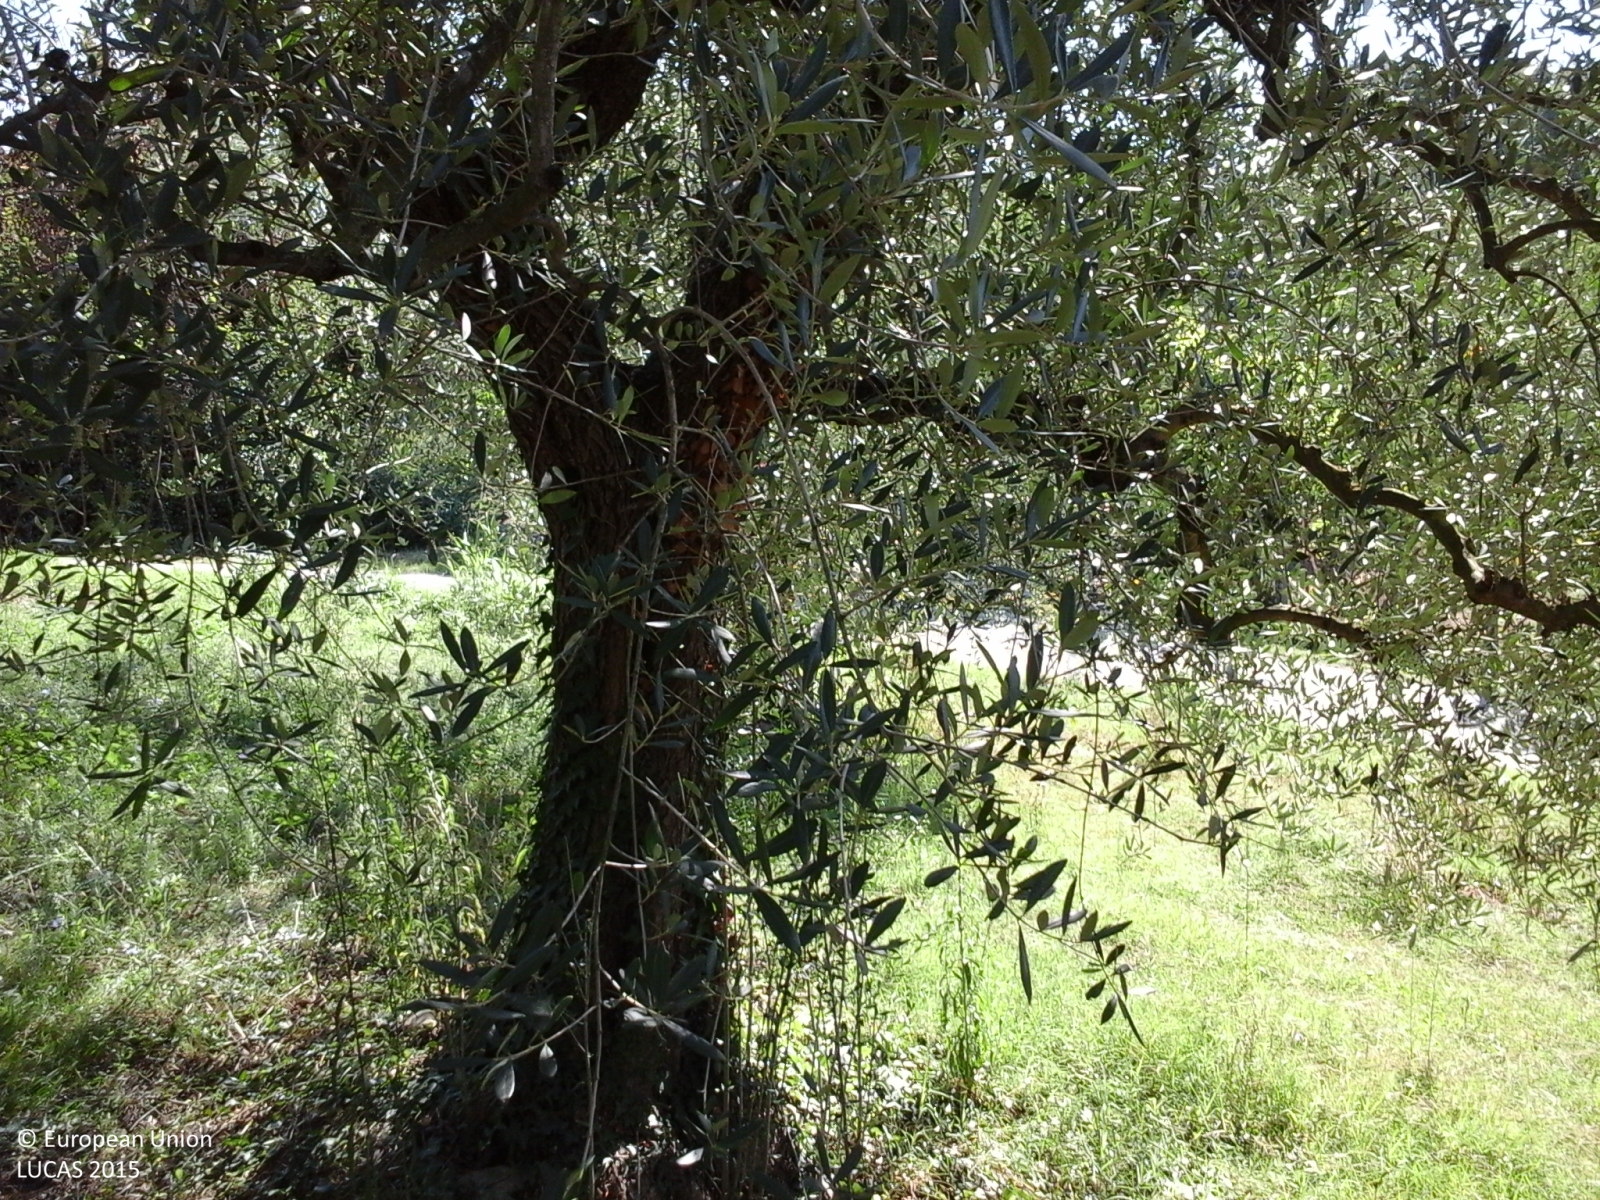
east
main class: Cropland
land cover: Olive groves
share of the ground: > 75 %
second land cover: Grassland without tree/shrub cover
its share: > 75 %
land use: Agriculture (excluding fallow land and kitchen gardens)
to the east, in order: Olive groves; Grassland without tree/shrub cover; Paved roads, cycling and walking lanes; Fences; Other fruit trees and berries; Fences; Other fresh vegetables; Broadleaved woodland; Fences; Olive groves; Fences; Grass margins; Paved roads, cycling and walking lanes; Fences; Lines of trees; Olive groves; Fences; Lines of trees; Tracks; Lines of trees; Olive groves; Tracks; Olive groves
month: September
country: IT
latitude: 43.8777
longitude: 12.8682
